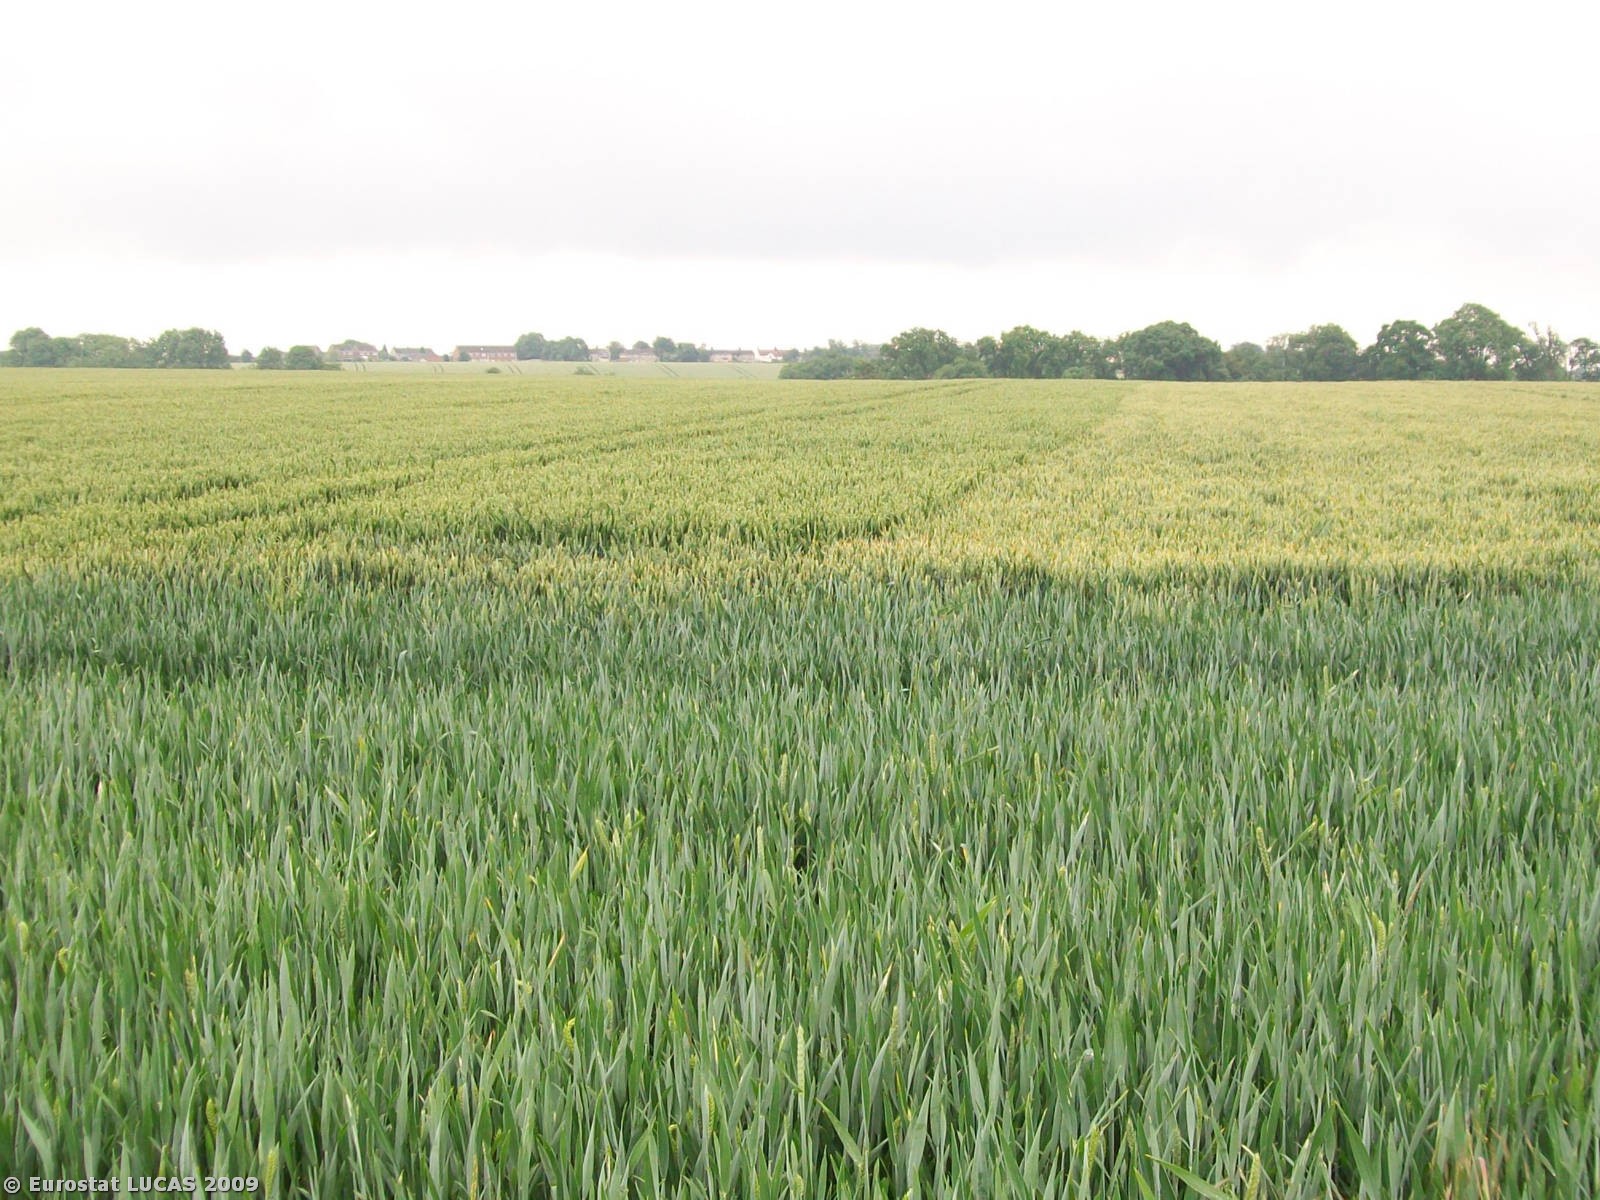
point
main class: Cropland
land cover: Common wheat
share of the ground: > 75 %
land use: Agriculture (excluding fallow land and kitchen gardens)
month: June
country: GB
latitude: 51.2368
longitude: -2.1929
